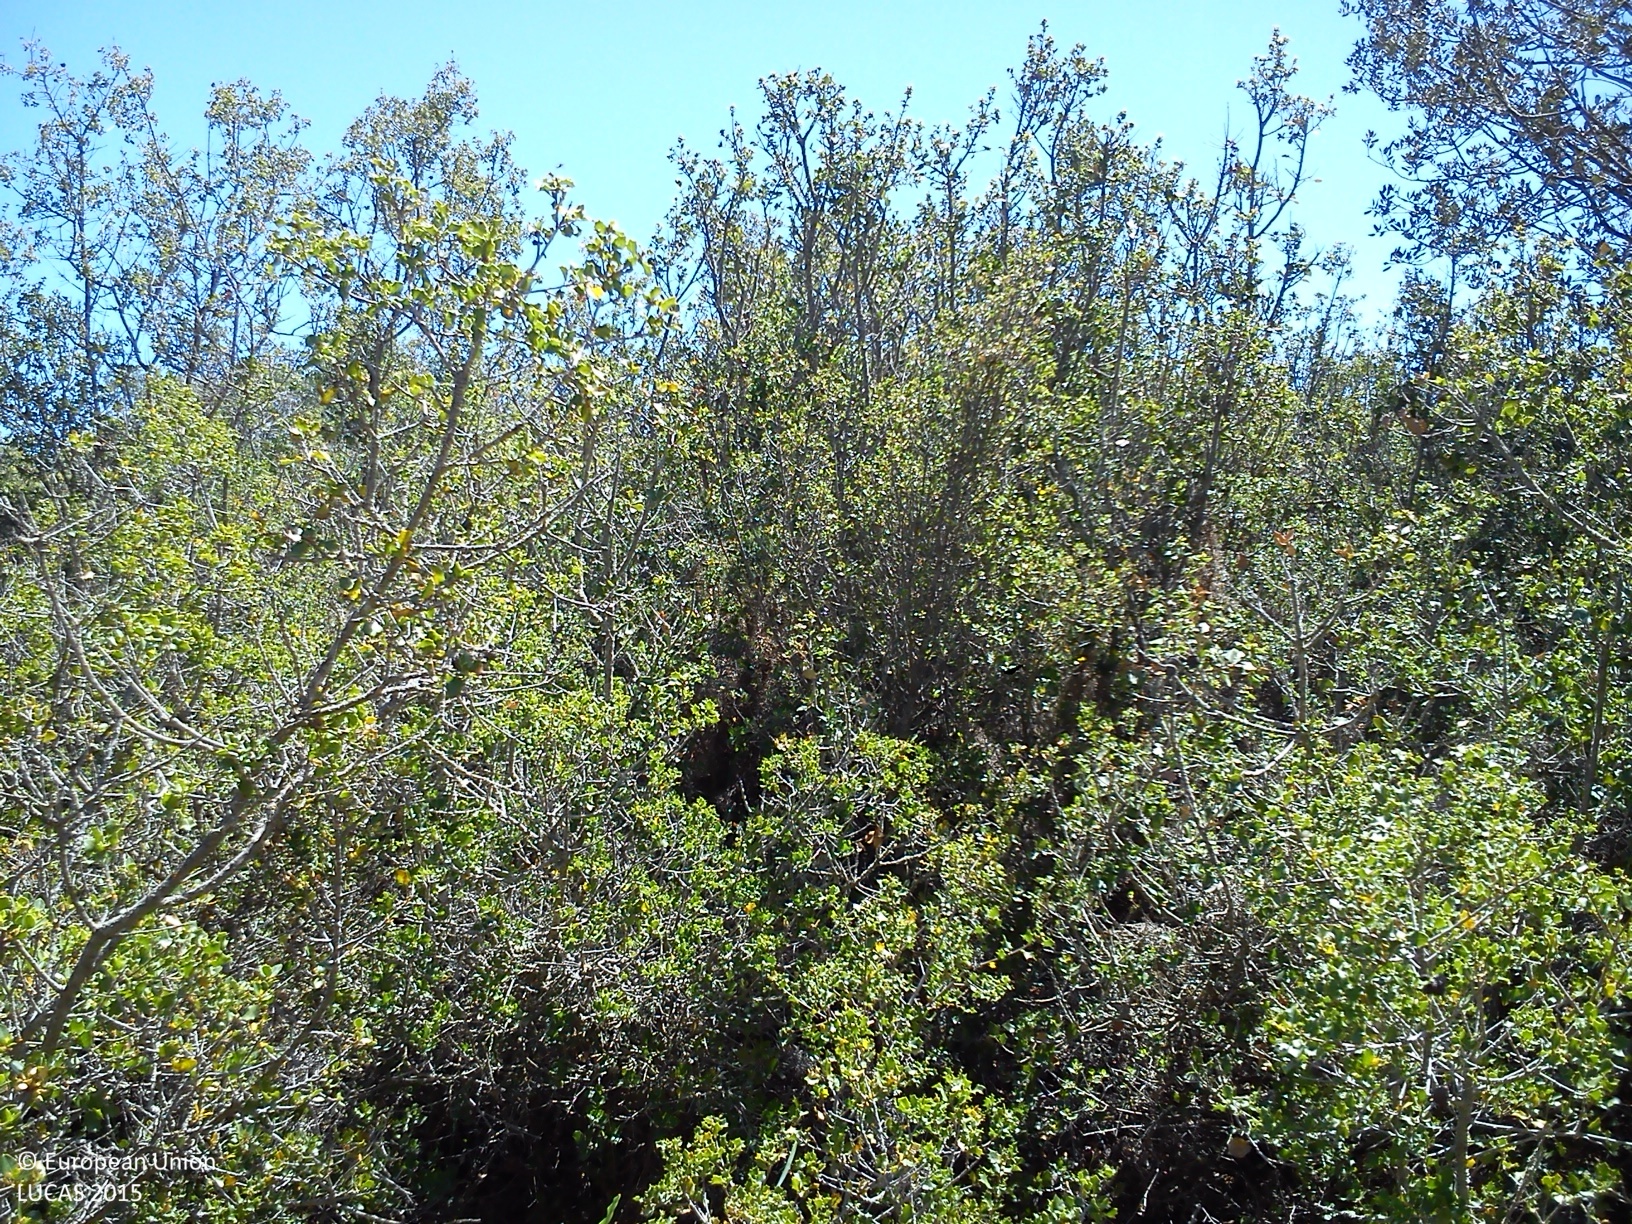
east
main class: Shrubland
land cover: Shrubland with sparse tree cover
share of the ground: > 75 %
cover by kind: shrubs 90 %, coniferous forest trees 5 %, consolidated bare surface 5 %
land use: Semi-natural and natural areas not in use
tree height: < 5 m
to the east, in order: Shrubland with sparse tree cover
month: May
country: ES
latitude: 39.5328
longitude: -0.8787
